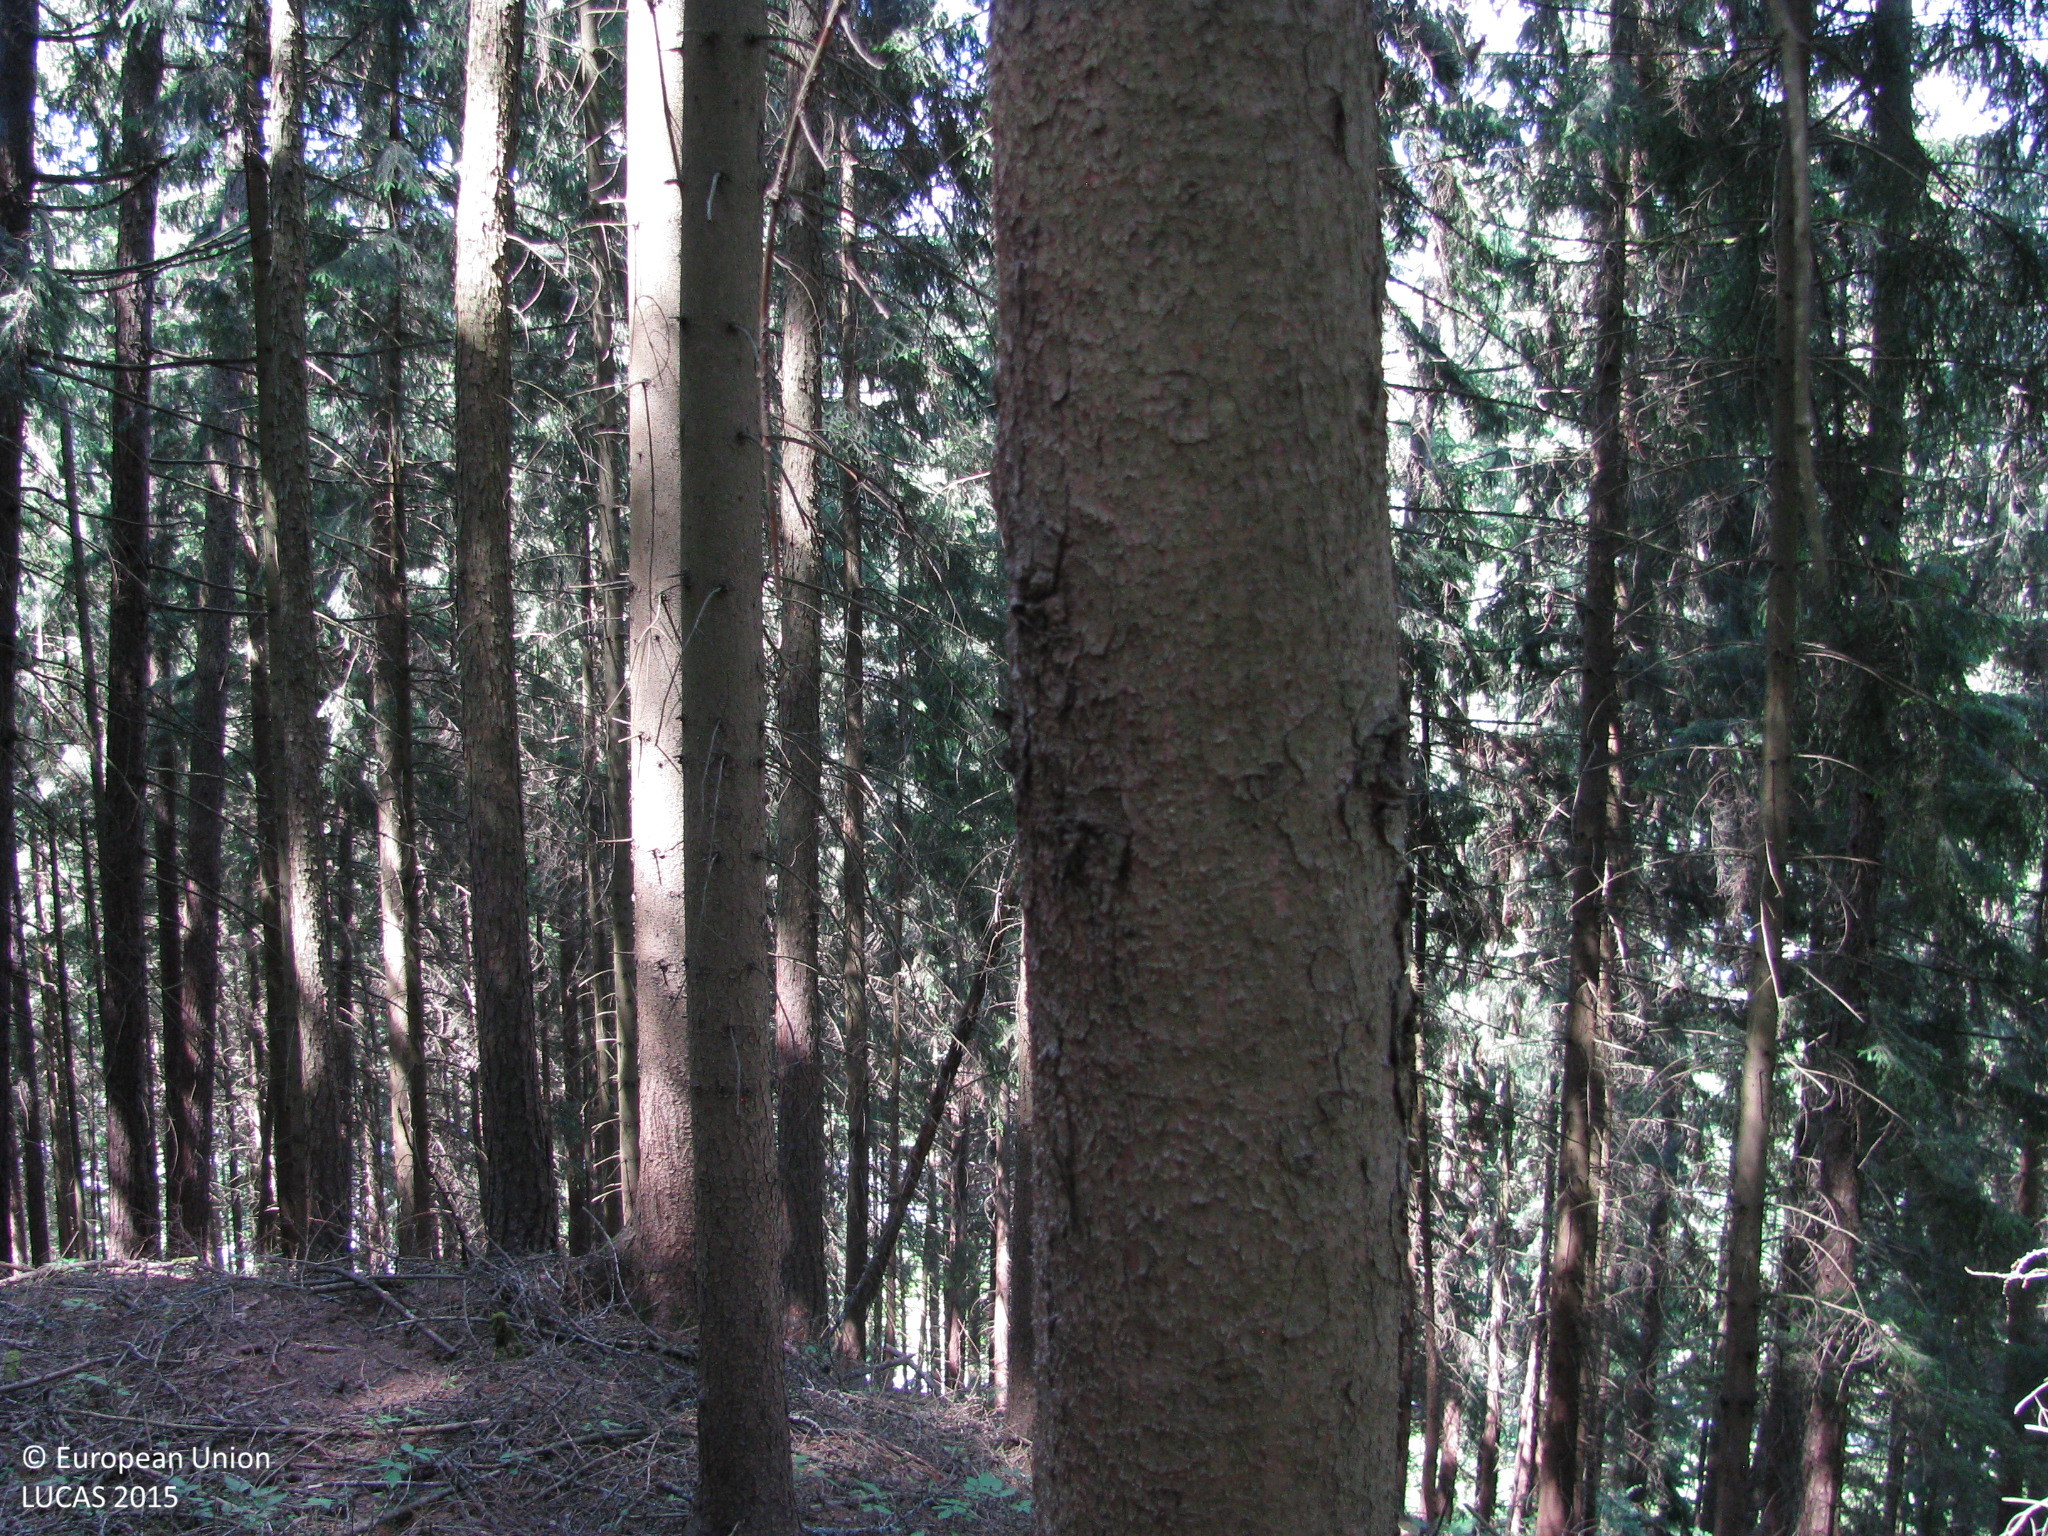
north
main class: Woodland
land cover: Spruce dominated coniferous woodland
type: alpine coniferous forest
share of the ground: > 75 %
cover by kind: coniferous forest trees 90 %, unconsolidated bare surface 10 %
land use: Forestry
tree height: > 5 m
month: June
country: AT
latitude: 47.3724
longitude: 14.9658
